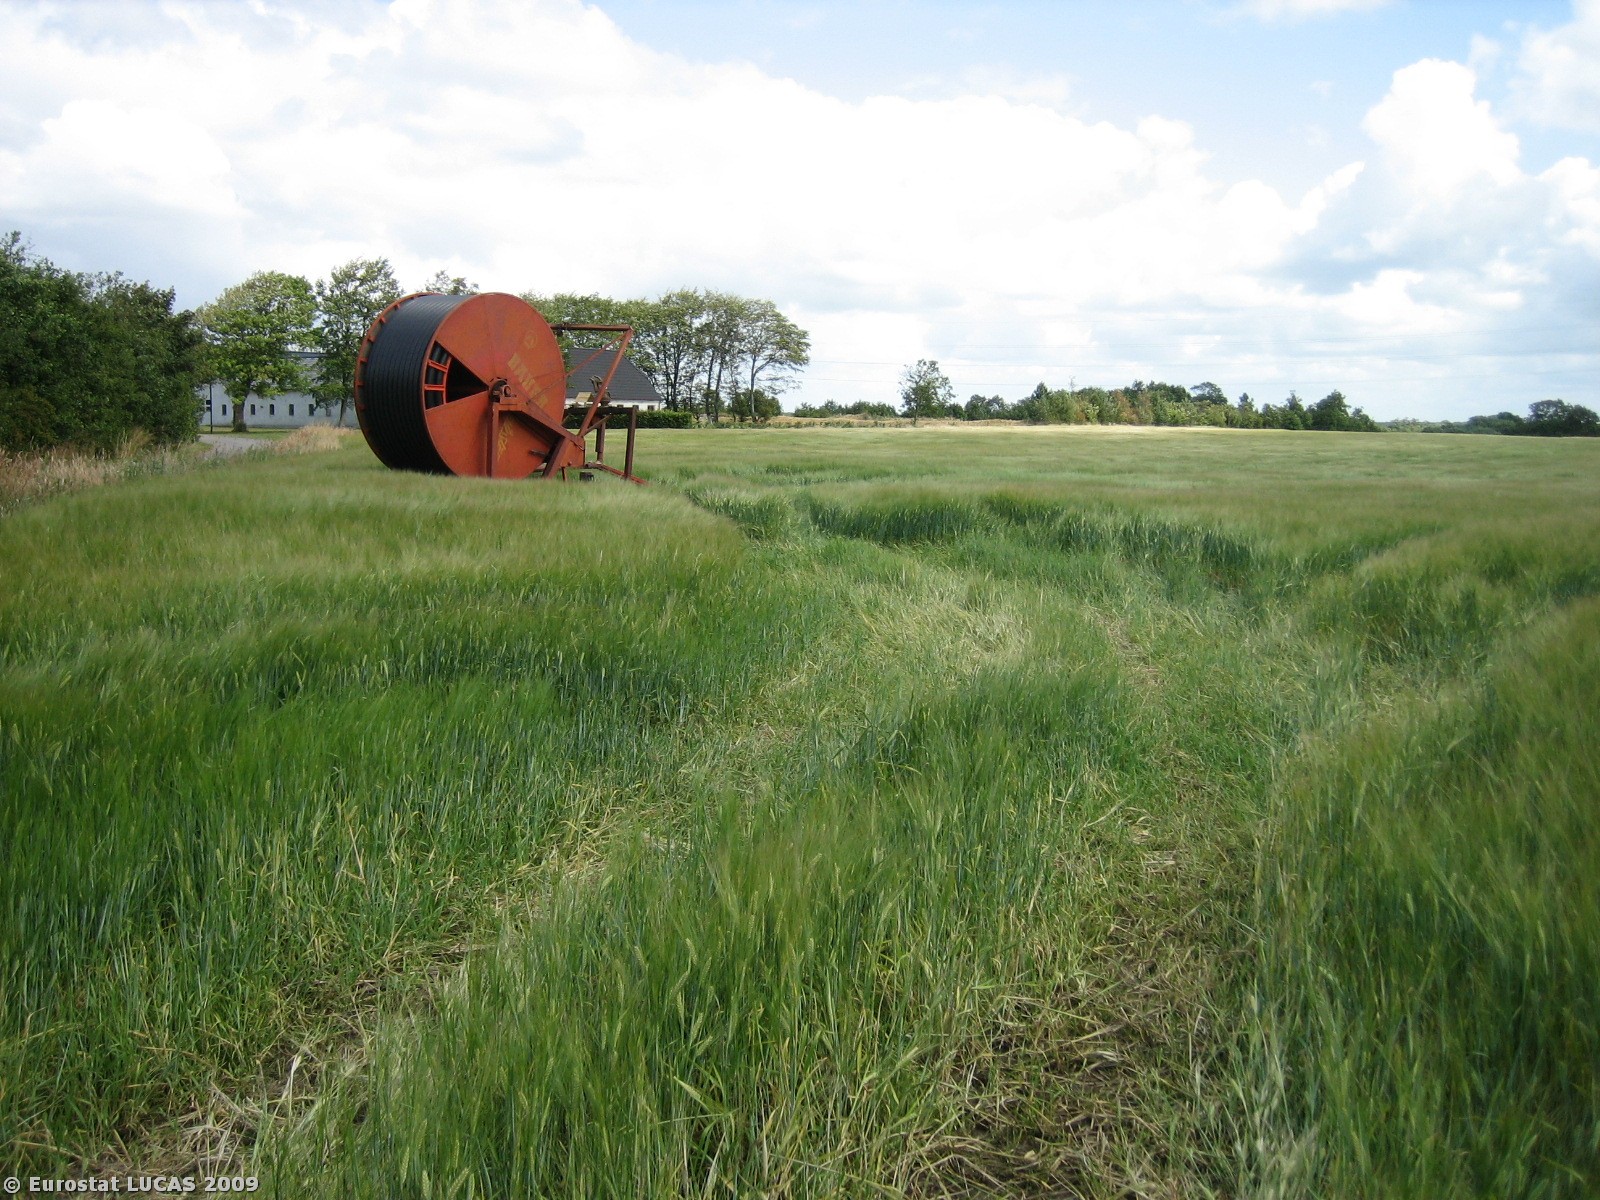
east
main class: Cropland
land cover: Barley
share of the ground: > 75 %
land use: Agriculture (excluding fallow land and kitchen gardens)
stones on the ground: < 10 %
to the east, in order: Barley; Grassland without tree/shrub cover
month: July
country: DK
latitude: 55.6942
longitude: 8.5536
